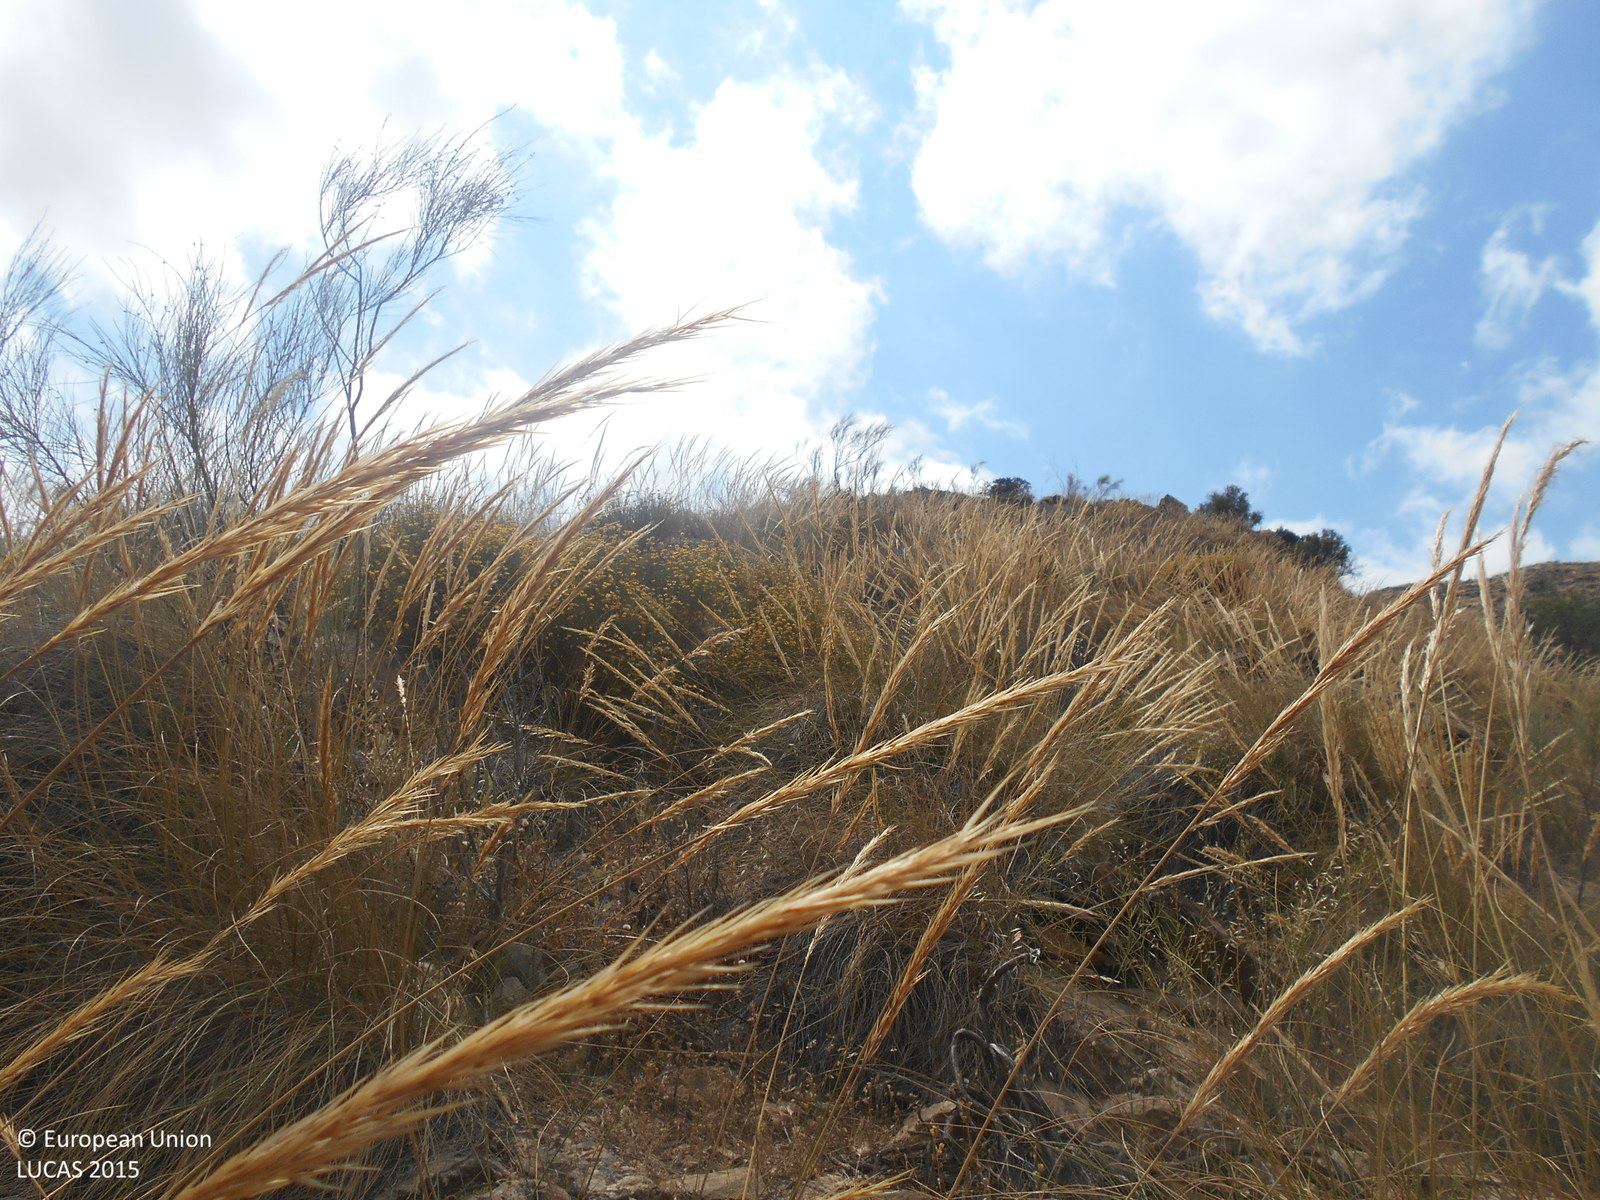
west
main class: Shrubland
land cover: Shrubland without tree cover
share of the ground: 50 - 75 %
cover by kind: shrubs 50 %, consolidated bare surface 30 %, herbaceous plants 20 %
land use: Semi-natural and natural areas not in use
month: May
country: ES
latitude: 37.1967
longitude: -2.2026
